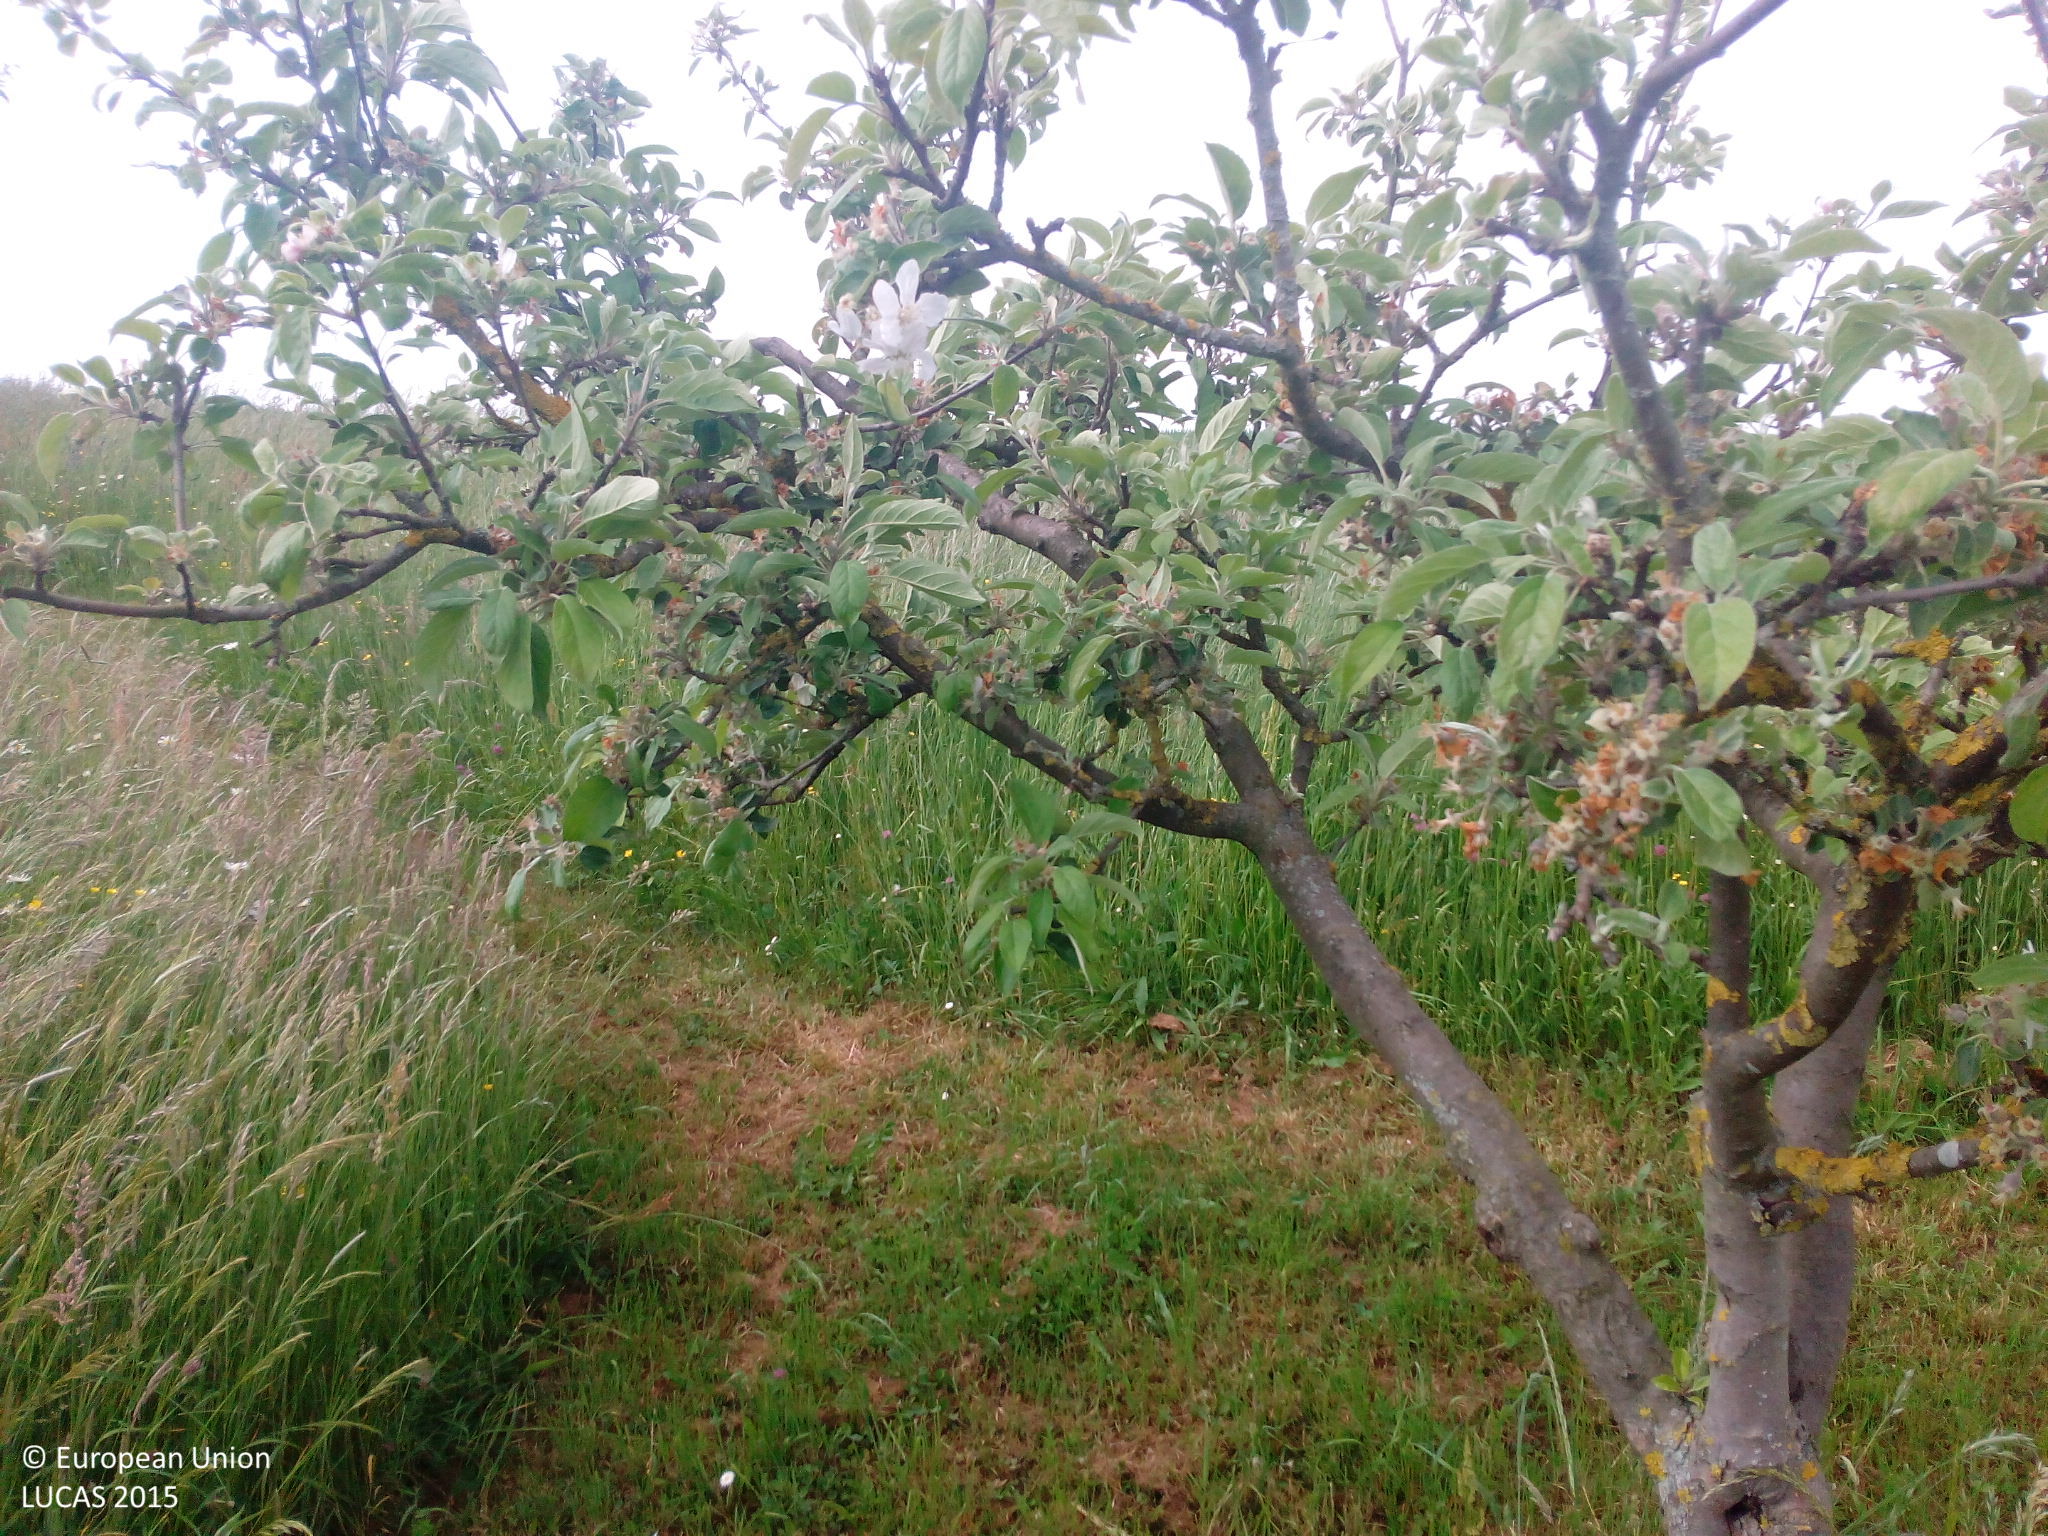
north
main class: Cropland
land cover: Apple fruit
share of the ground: 10 - 25 %
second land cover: Grassland without tree/shrub cover
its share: > 75 %
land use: Agriculture (excluding fallow land and kitchen gardens)
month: May
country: DE
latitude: 50.1804
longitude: 10.9380
